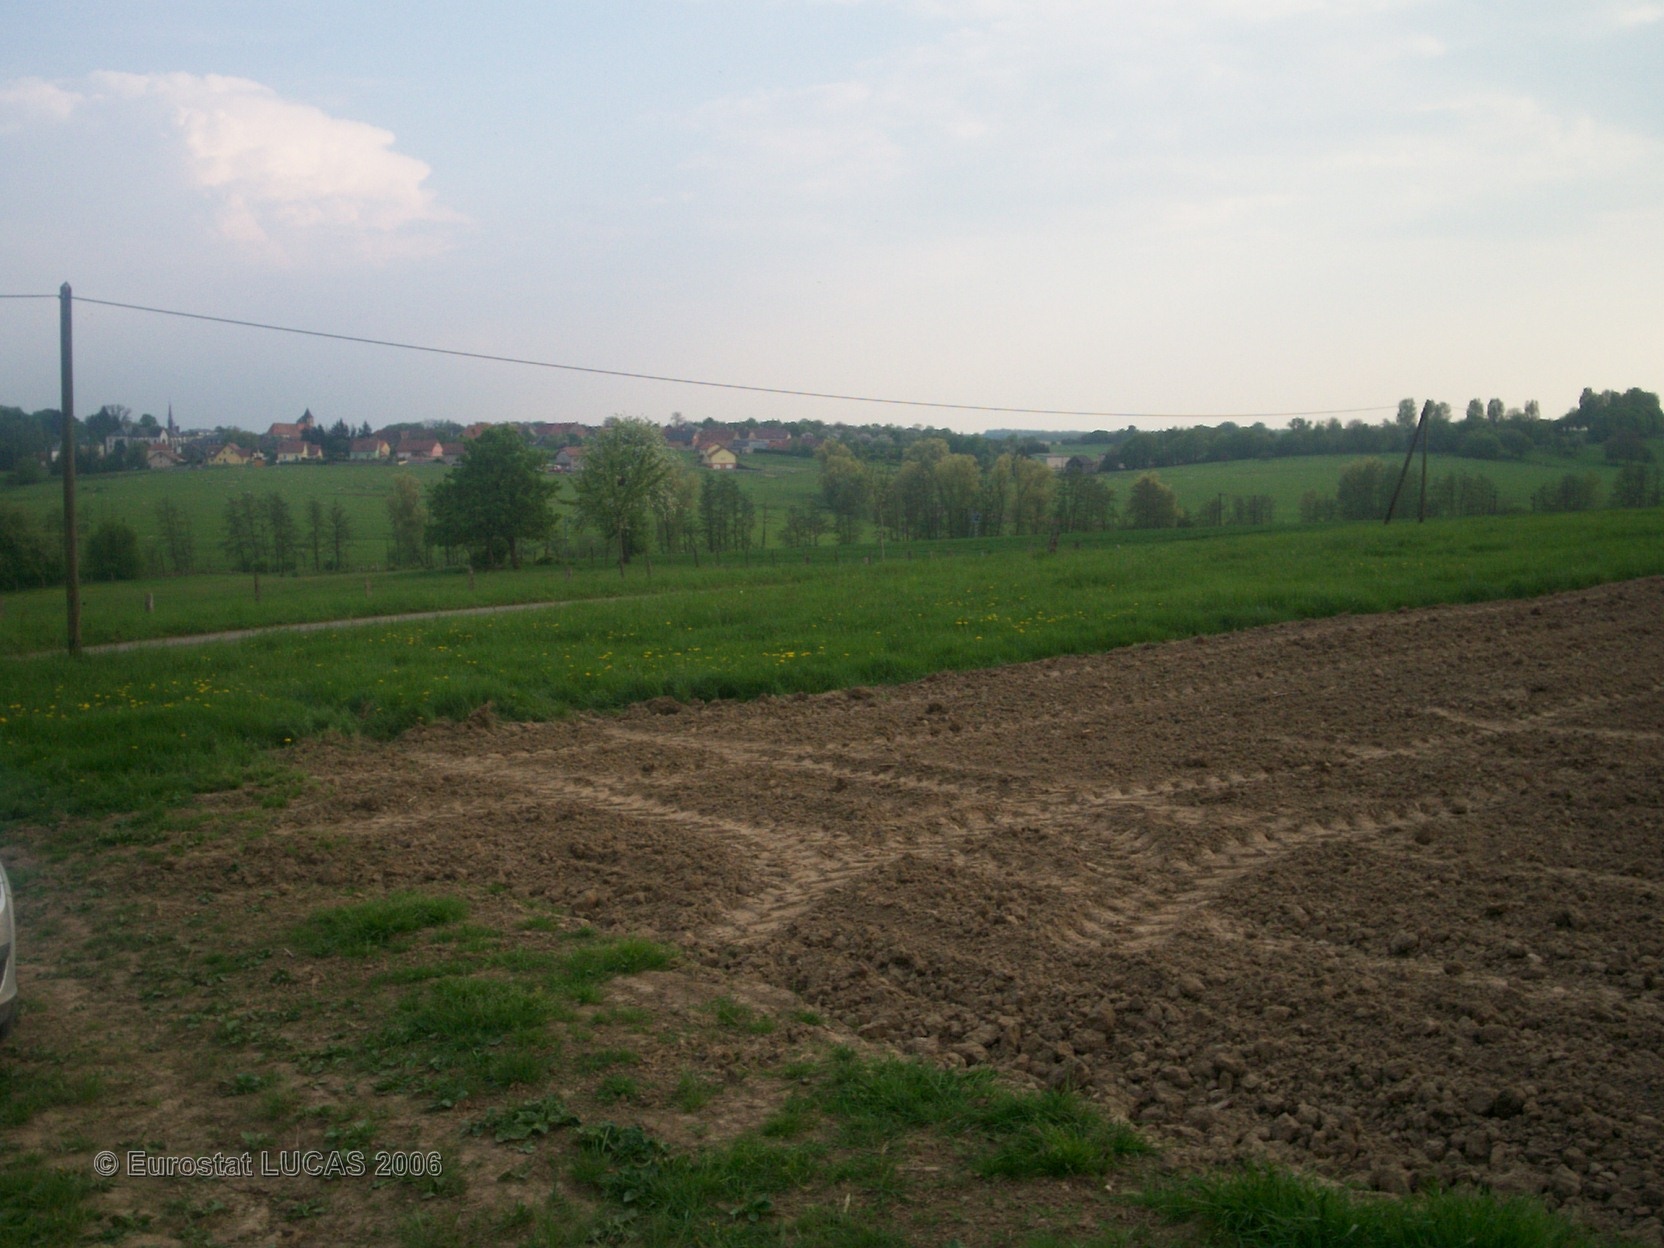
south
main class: Artificial land
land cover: Non built-up linear features
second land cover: Grassland without tree/shrub cover
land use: Road transport
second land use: Agriculture (excluding fallow land and kitchen gardens)
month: May
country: FR
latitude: 48.8127
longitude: 6.9910
